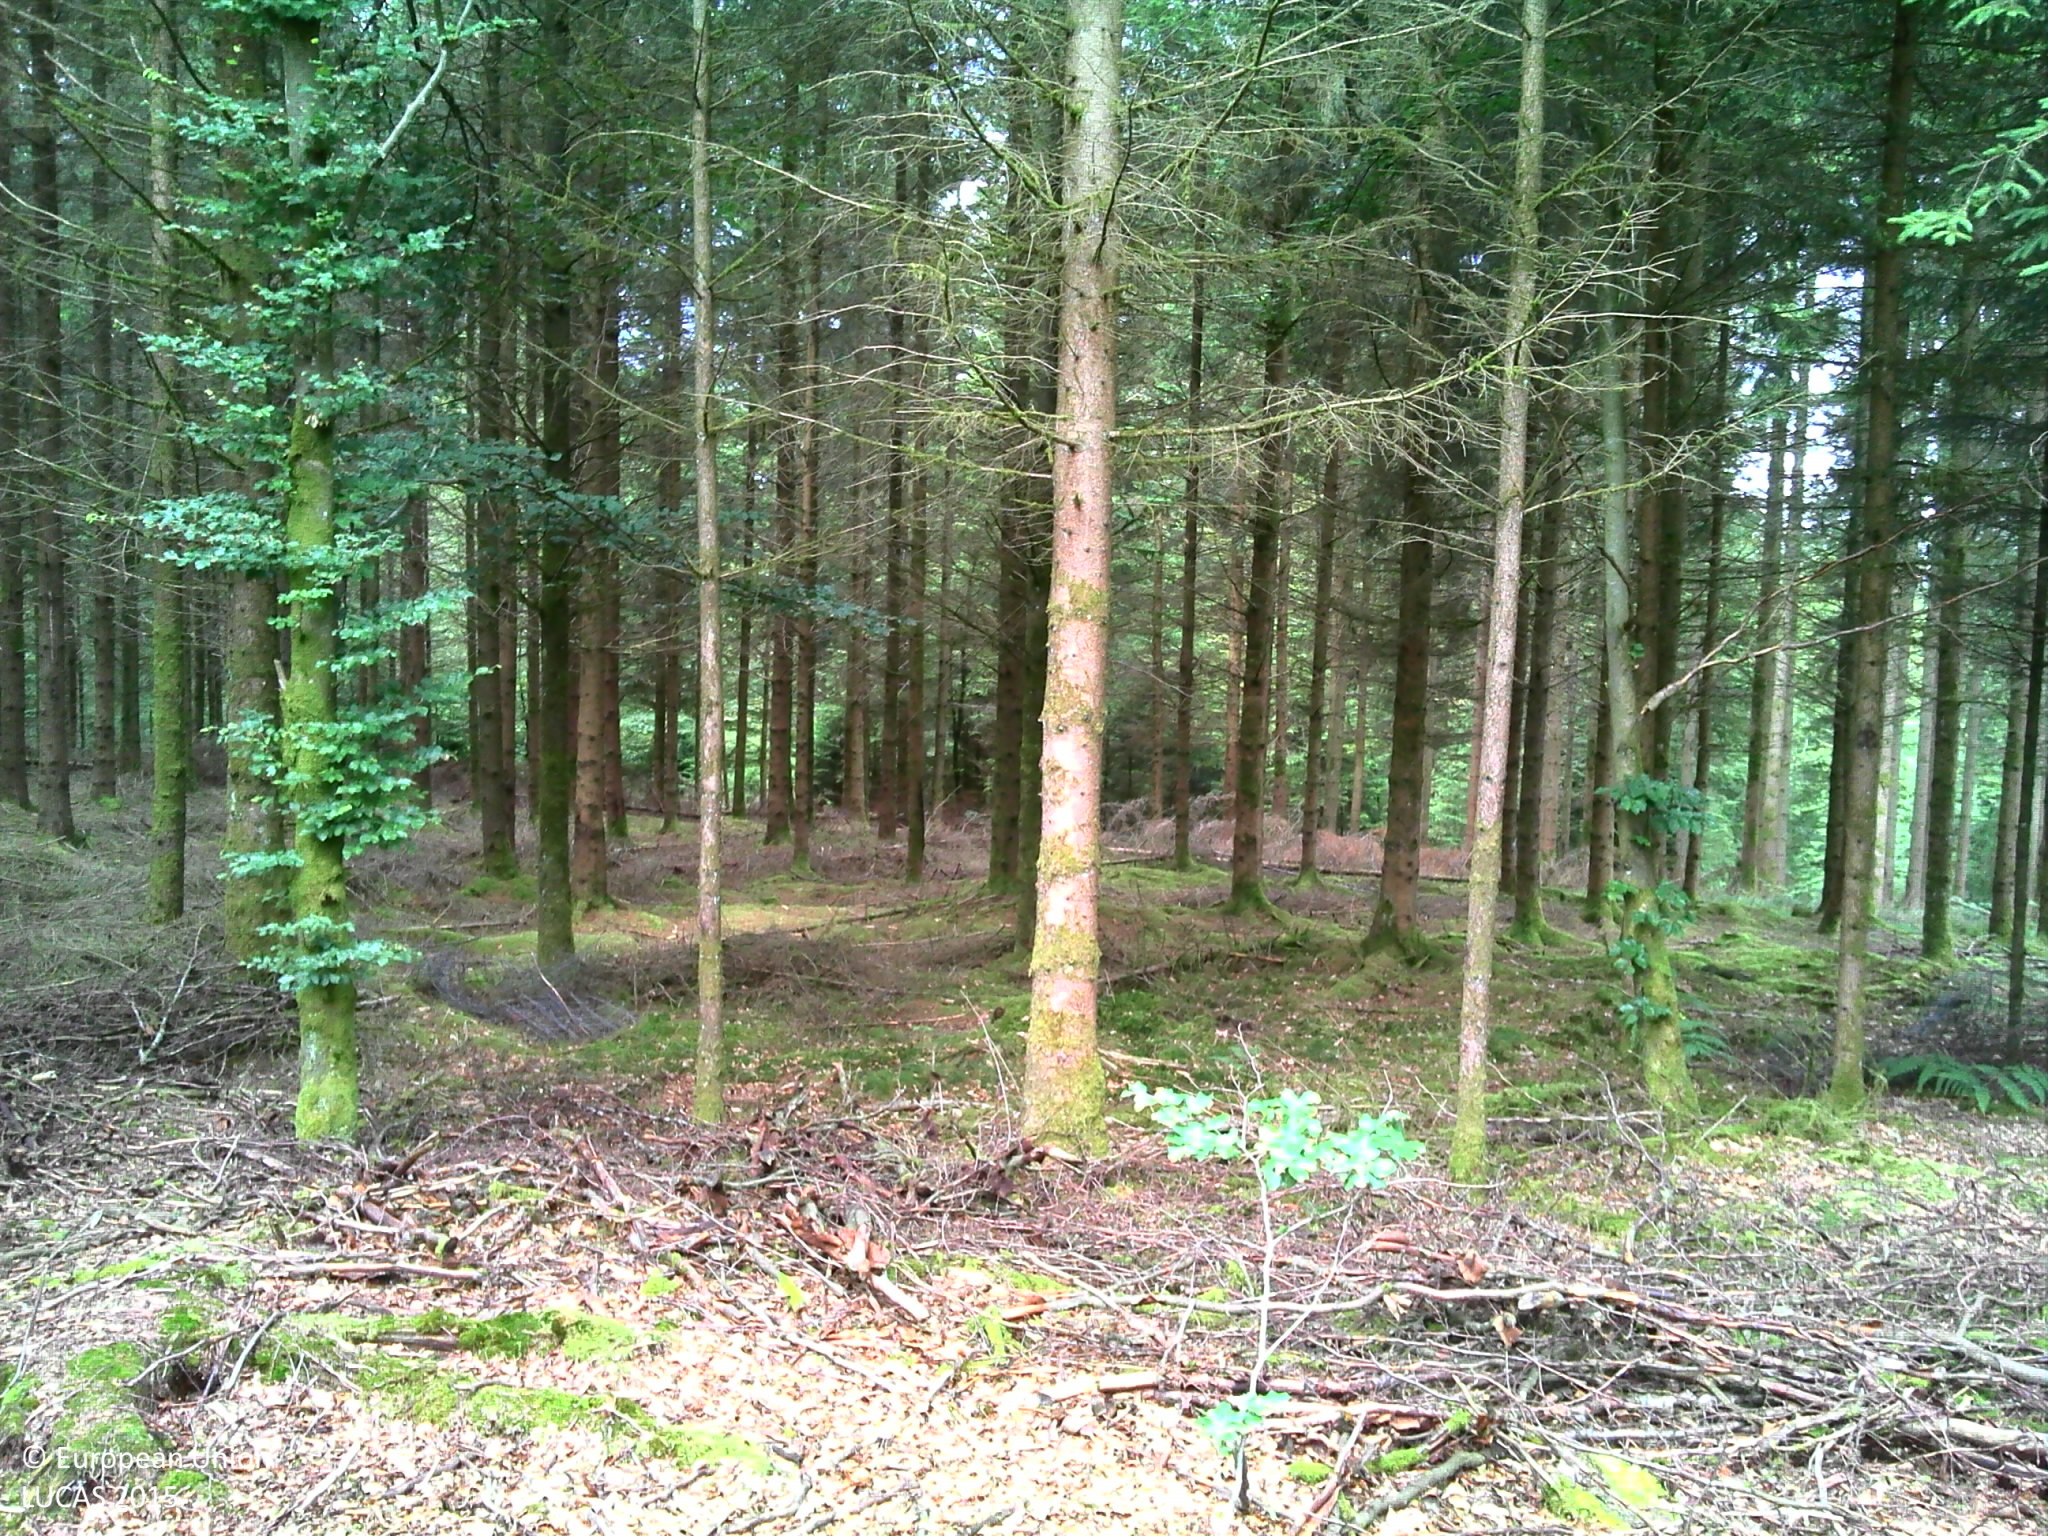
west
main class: Woodland
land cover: Broadleaved woodland
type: beech forest
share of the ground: 50 - 75 %
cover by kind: broadleaved forest trees 50 %, unconsolidated bare surface 25 %, herbaceous plants 20 %, coniferous forest trees 5 %
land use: Forestry
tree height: > 5 m
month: July
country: BE
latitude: 49.7662
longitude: 5.3749
